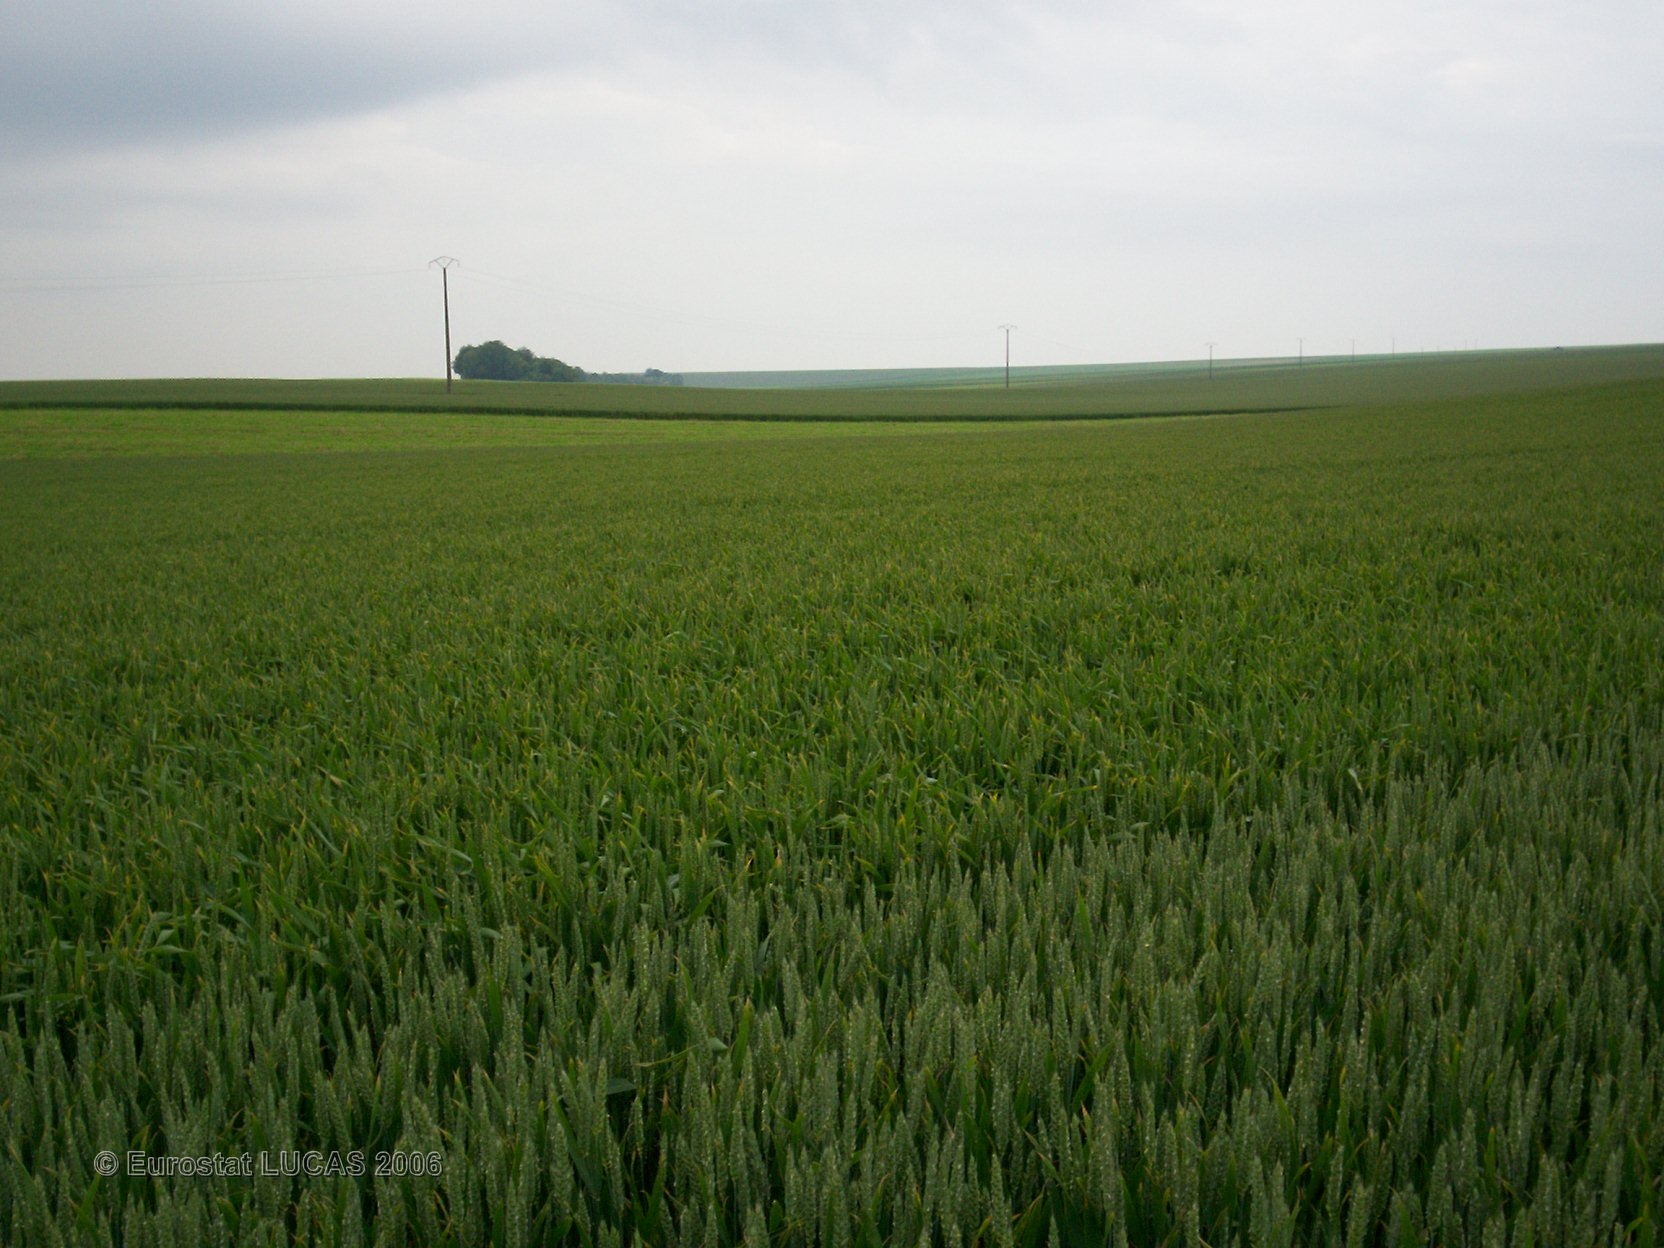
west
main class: Cropland
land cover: Common wheat
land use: Agriculture (excluding fallow land and kitchen gardens)
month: June
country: FR
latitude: 48.7529
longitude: 4.4882
